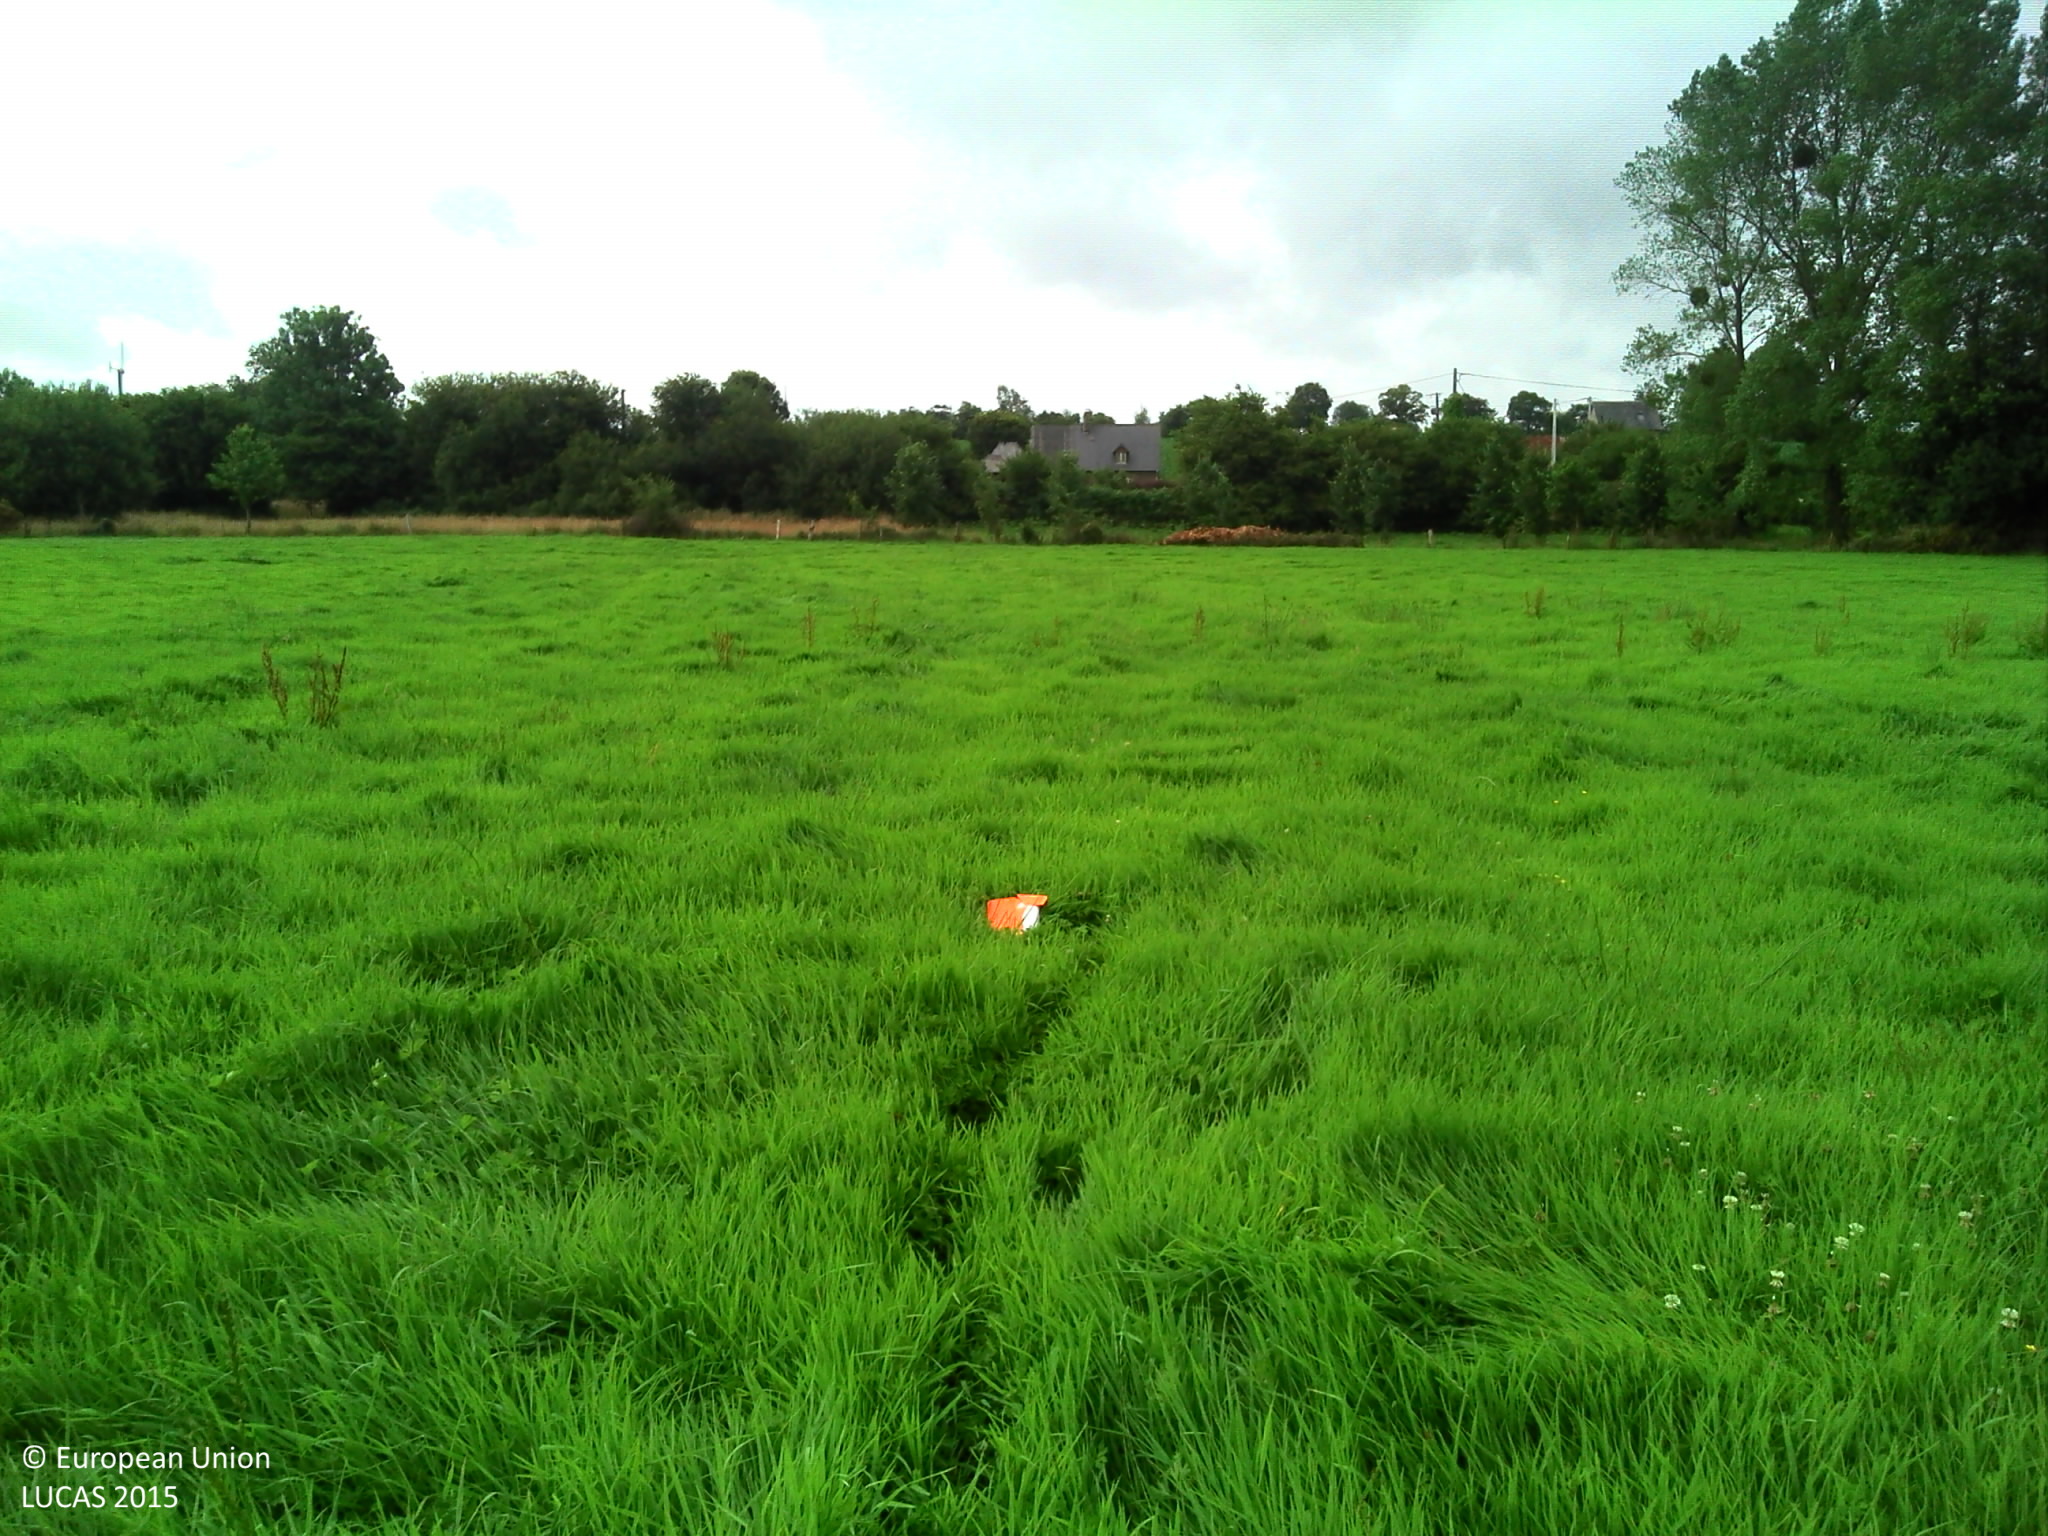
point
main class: Grassland
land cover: Grassland without tree/shrub cover
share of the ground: > 75 %
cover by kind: herbaceous plants 100 %
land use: Agriculture (excluding fallow land and kitchen gardens)
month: July
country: FR
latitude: 48.8614
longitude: -1.2632
